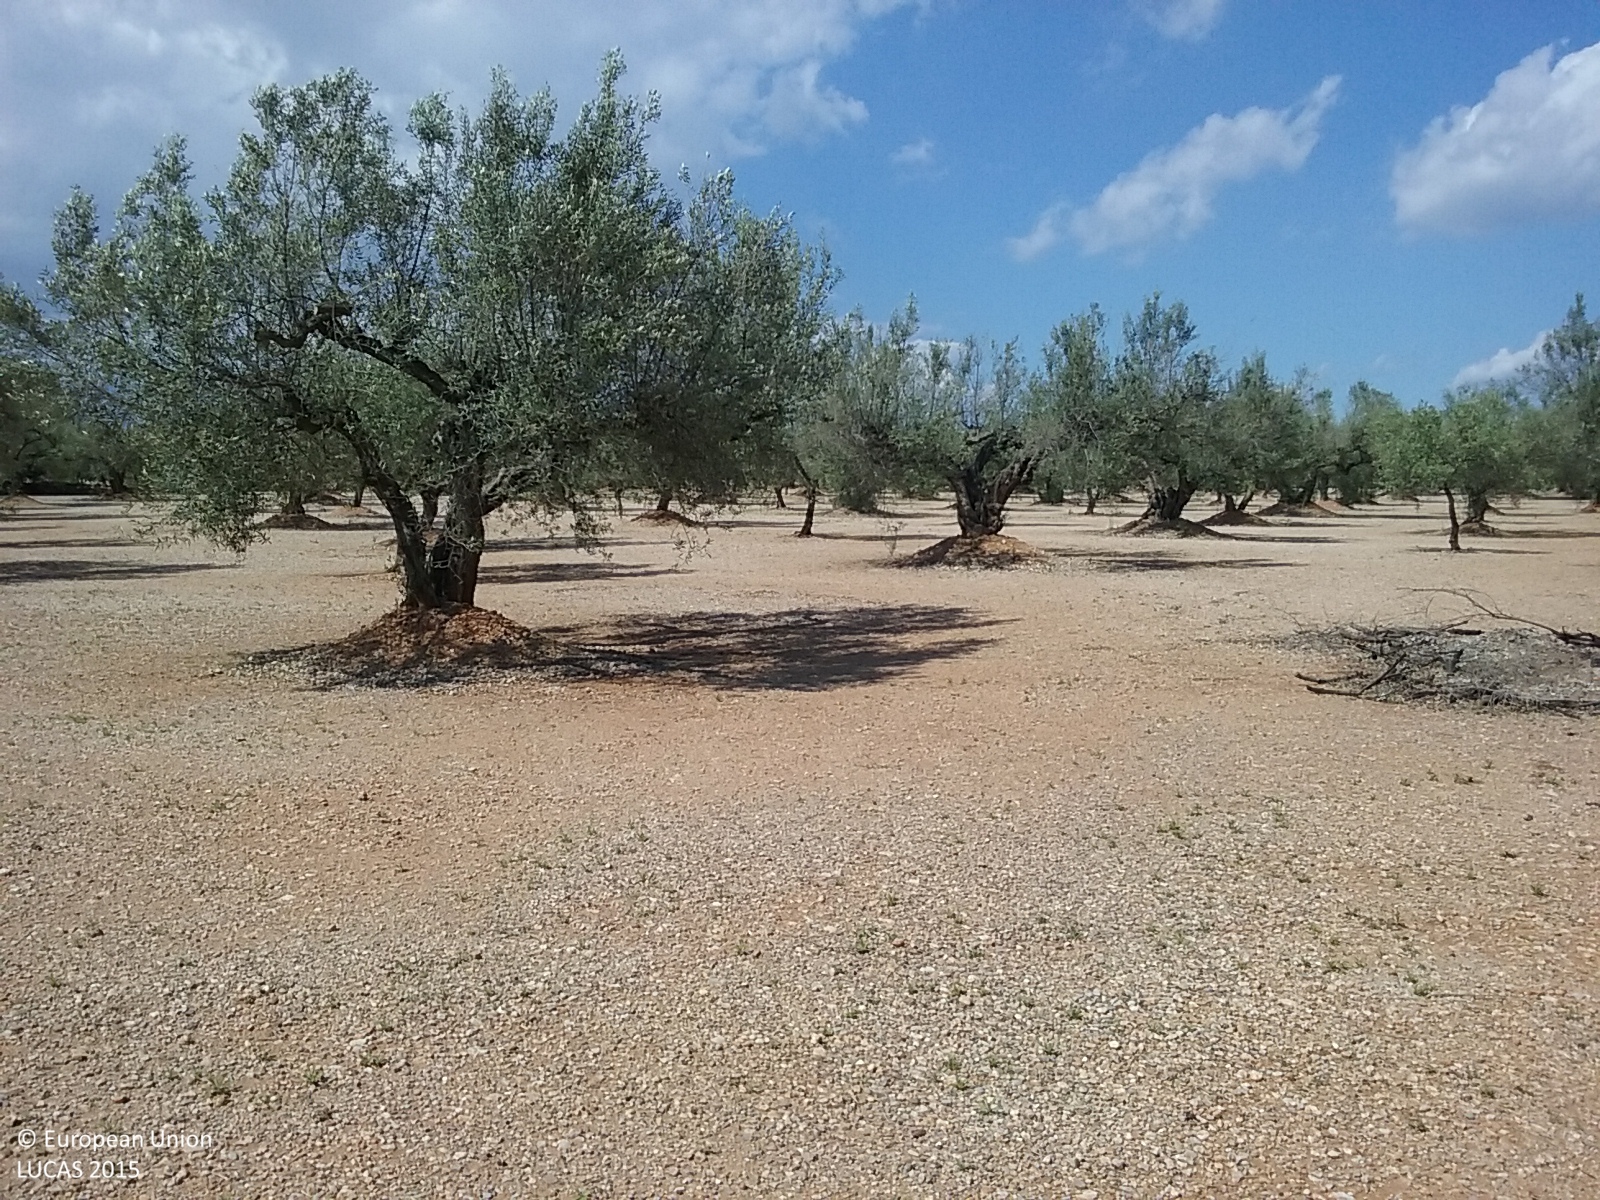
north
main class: Cropland
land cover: Olive groves
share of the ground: 10 - 25 %
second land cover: Other bare soil
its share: > 75 %
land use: Agriculture (excluding fallow land and kitchen gardens)
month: April
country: ES
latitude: 40.6919
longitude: 0.4449
